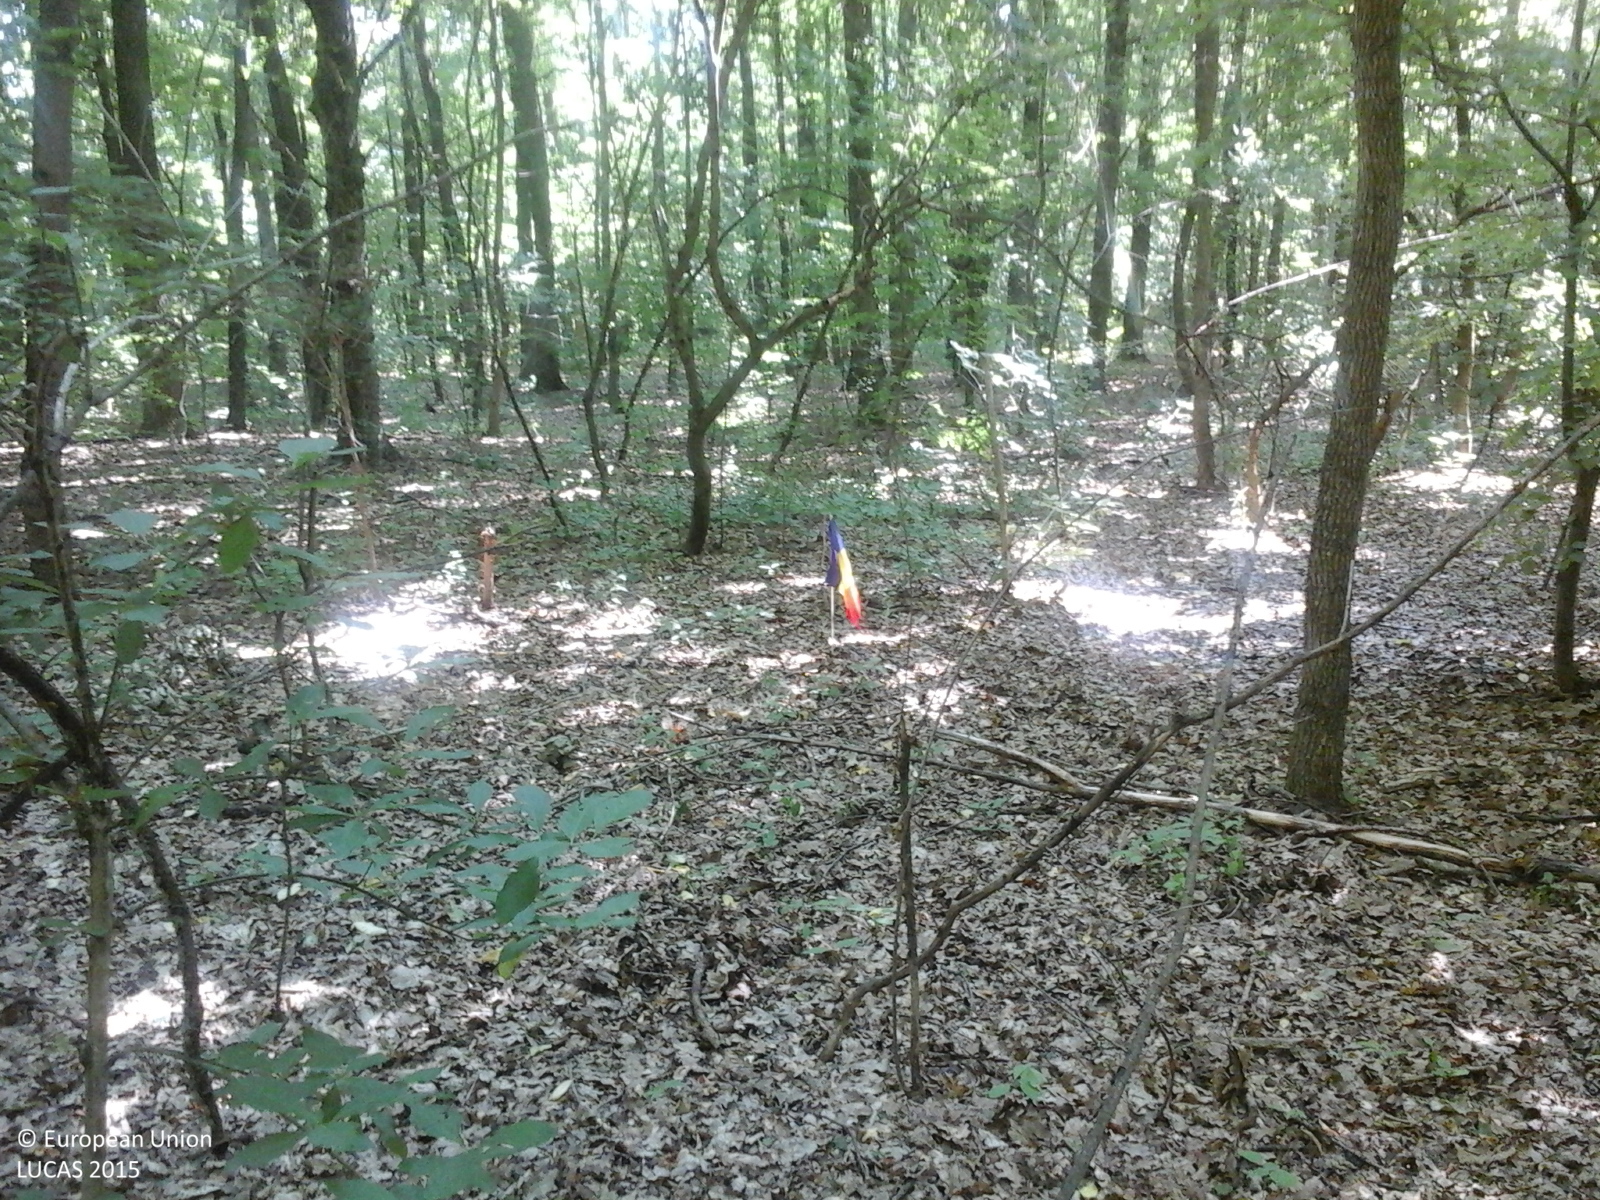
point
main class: Woodland
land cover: Broadleaved woodland
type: beech forest
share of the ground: > 75 %
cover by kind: broadleaved forest trees 100 %
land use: Forestry
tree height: > 5 m
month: June
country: RO
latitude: 46.6983
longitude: 27.2767
